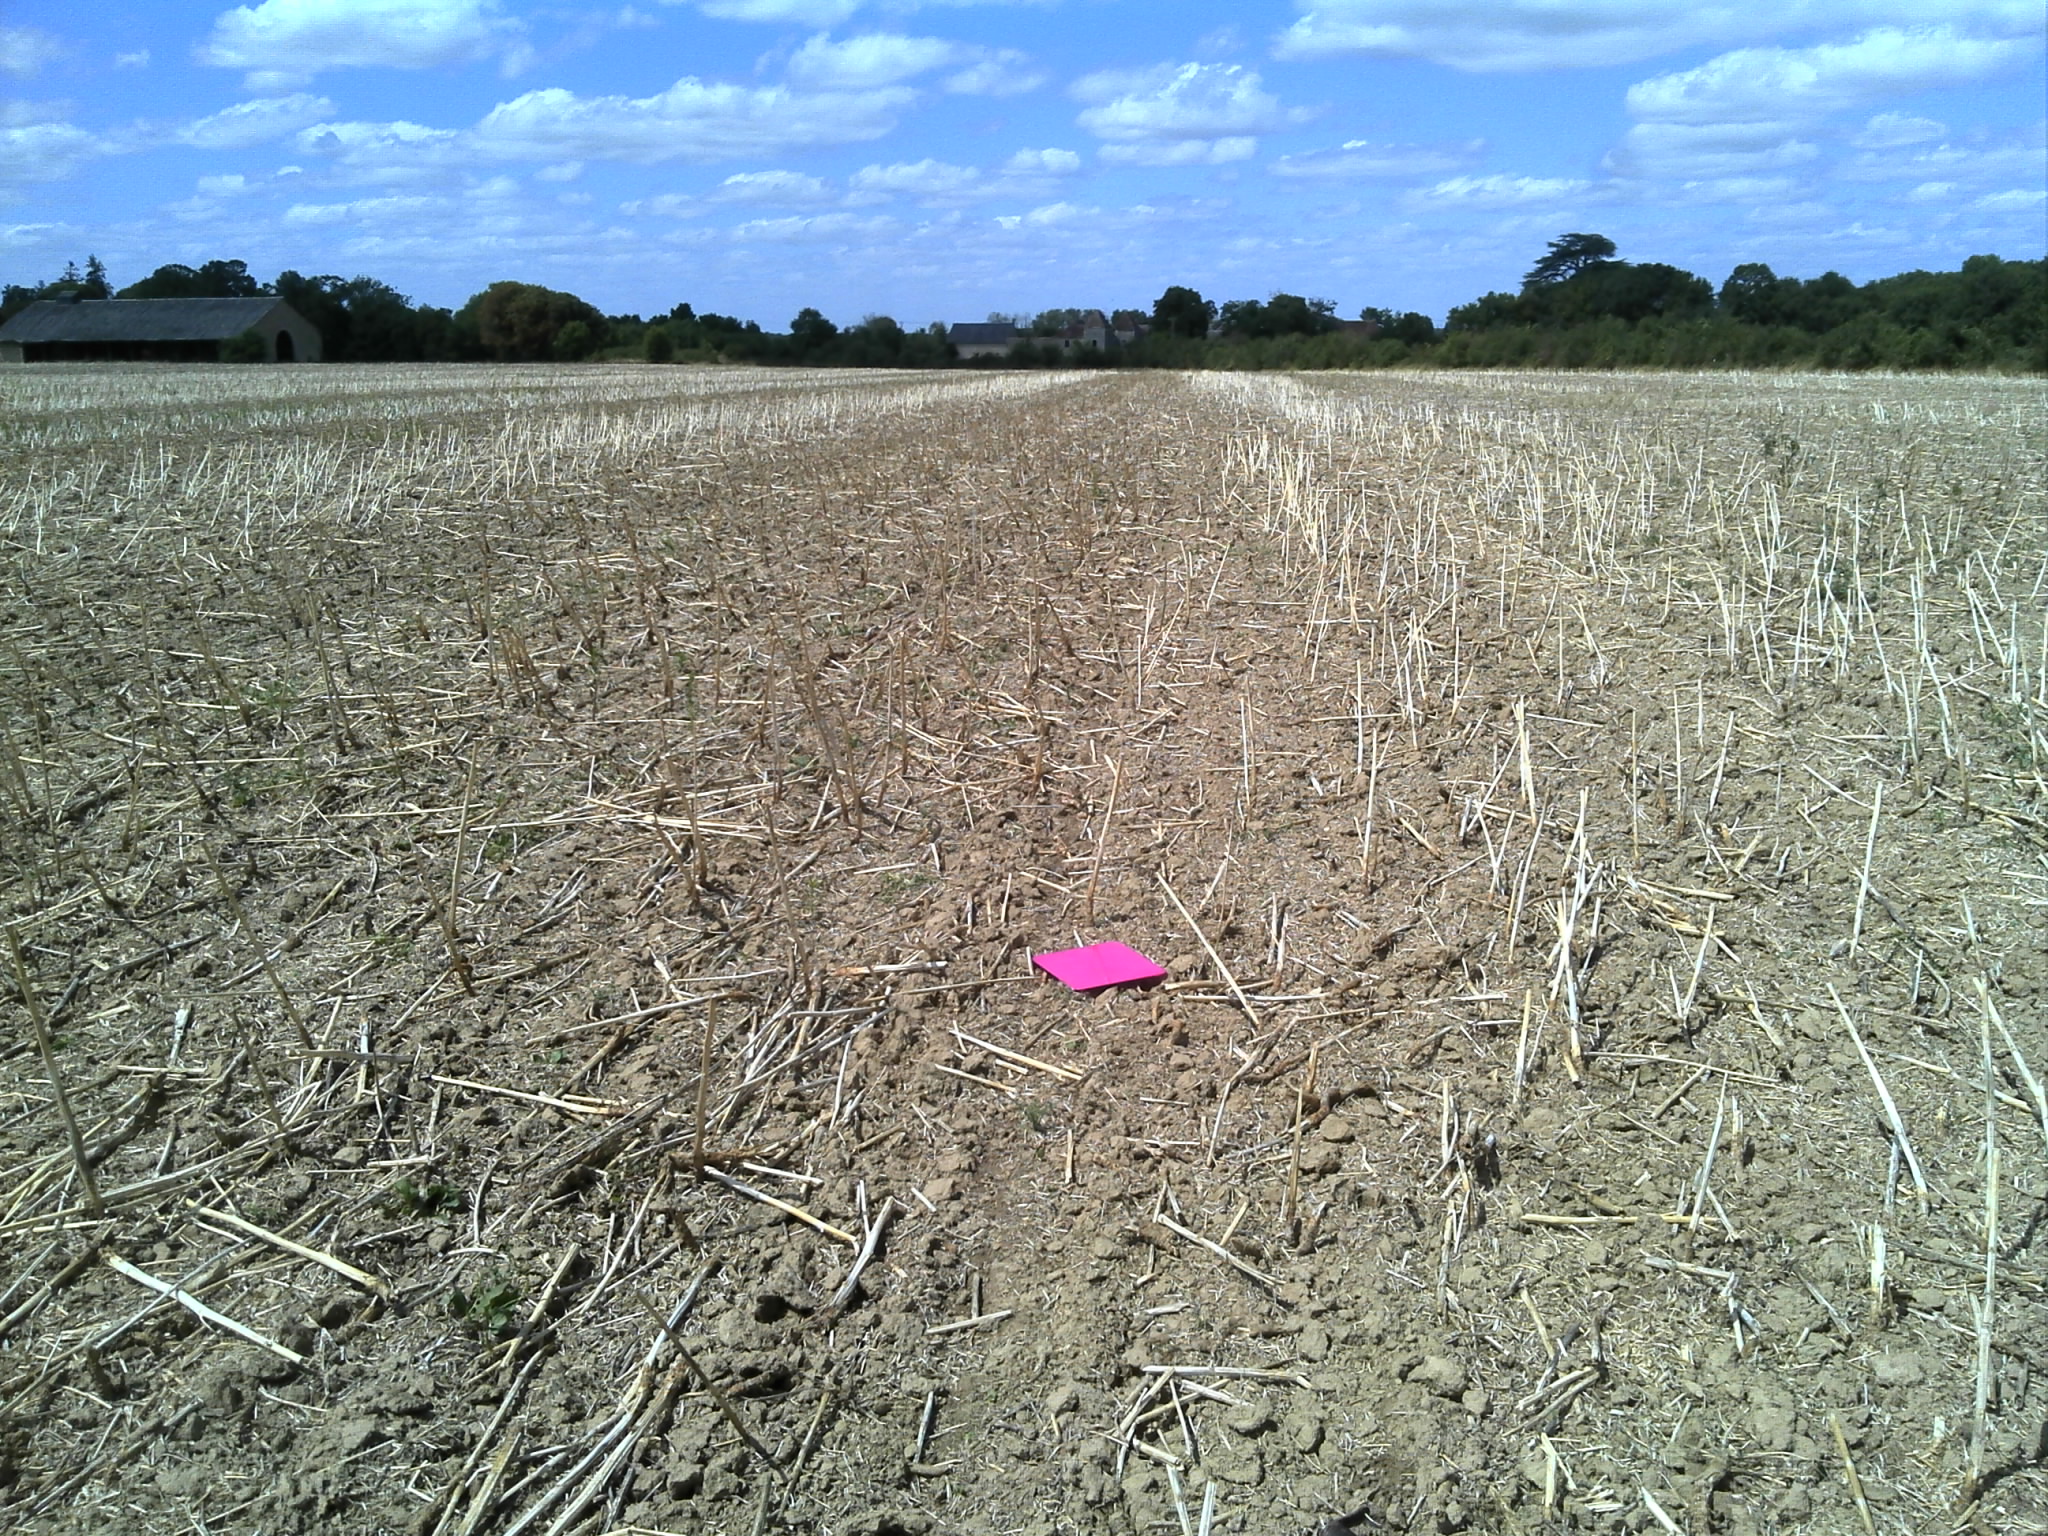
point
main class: Cropland
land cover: Rape and turnip rape
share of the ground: < 10 %
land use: Agriculture (excluding fallow land and kitchen gardens)
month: August
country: FR
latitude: 46.8557
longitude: 1.6344
